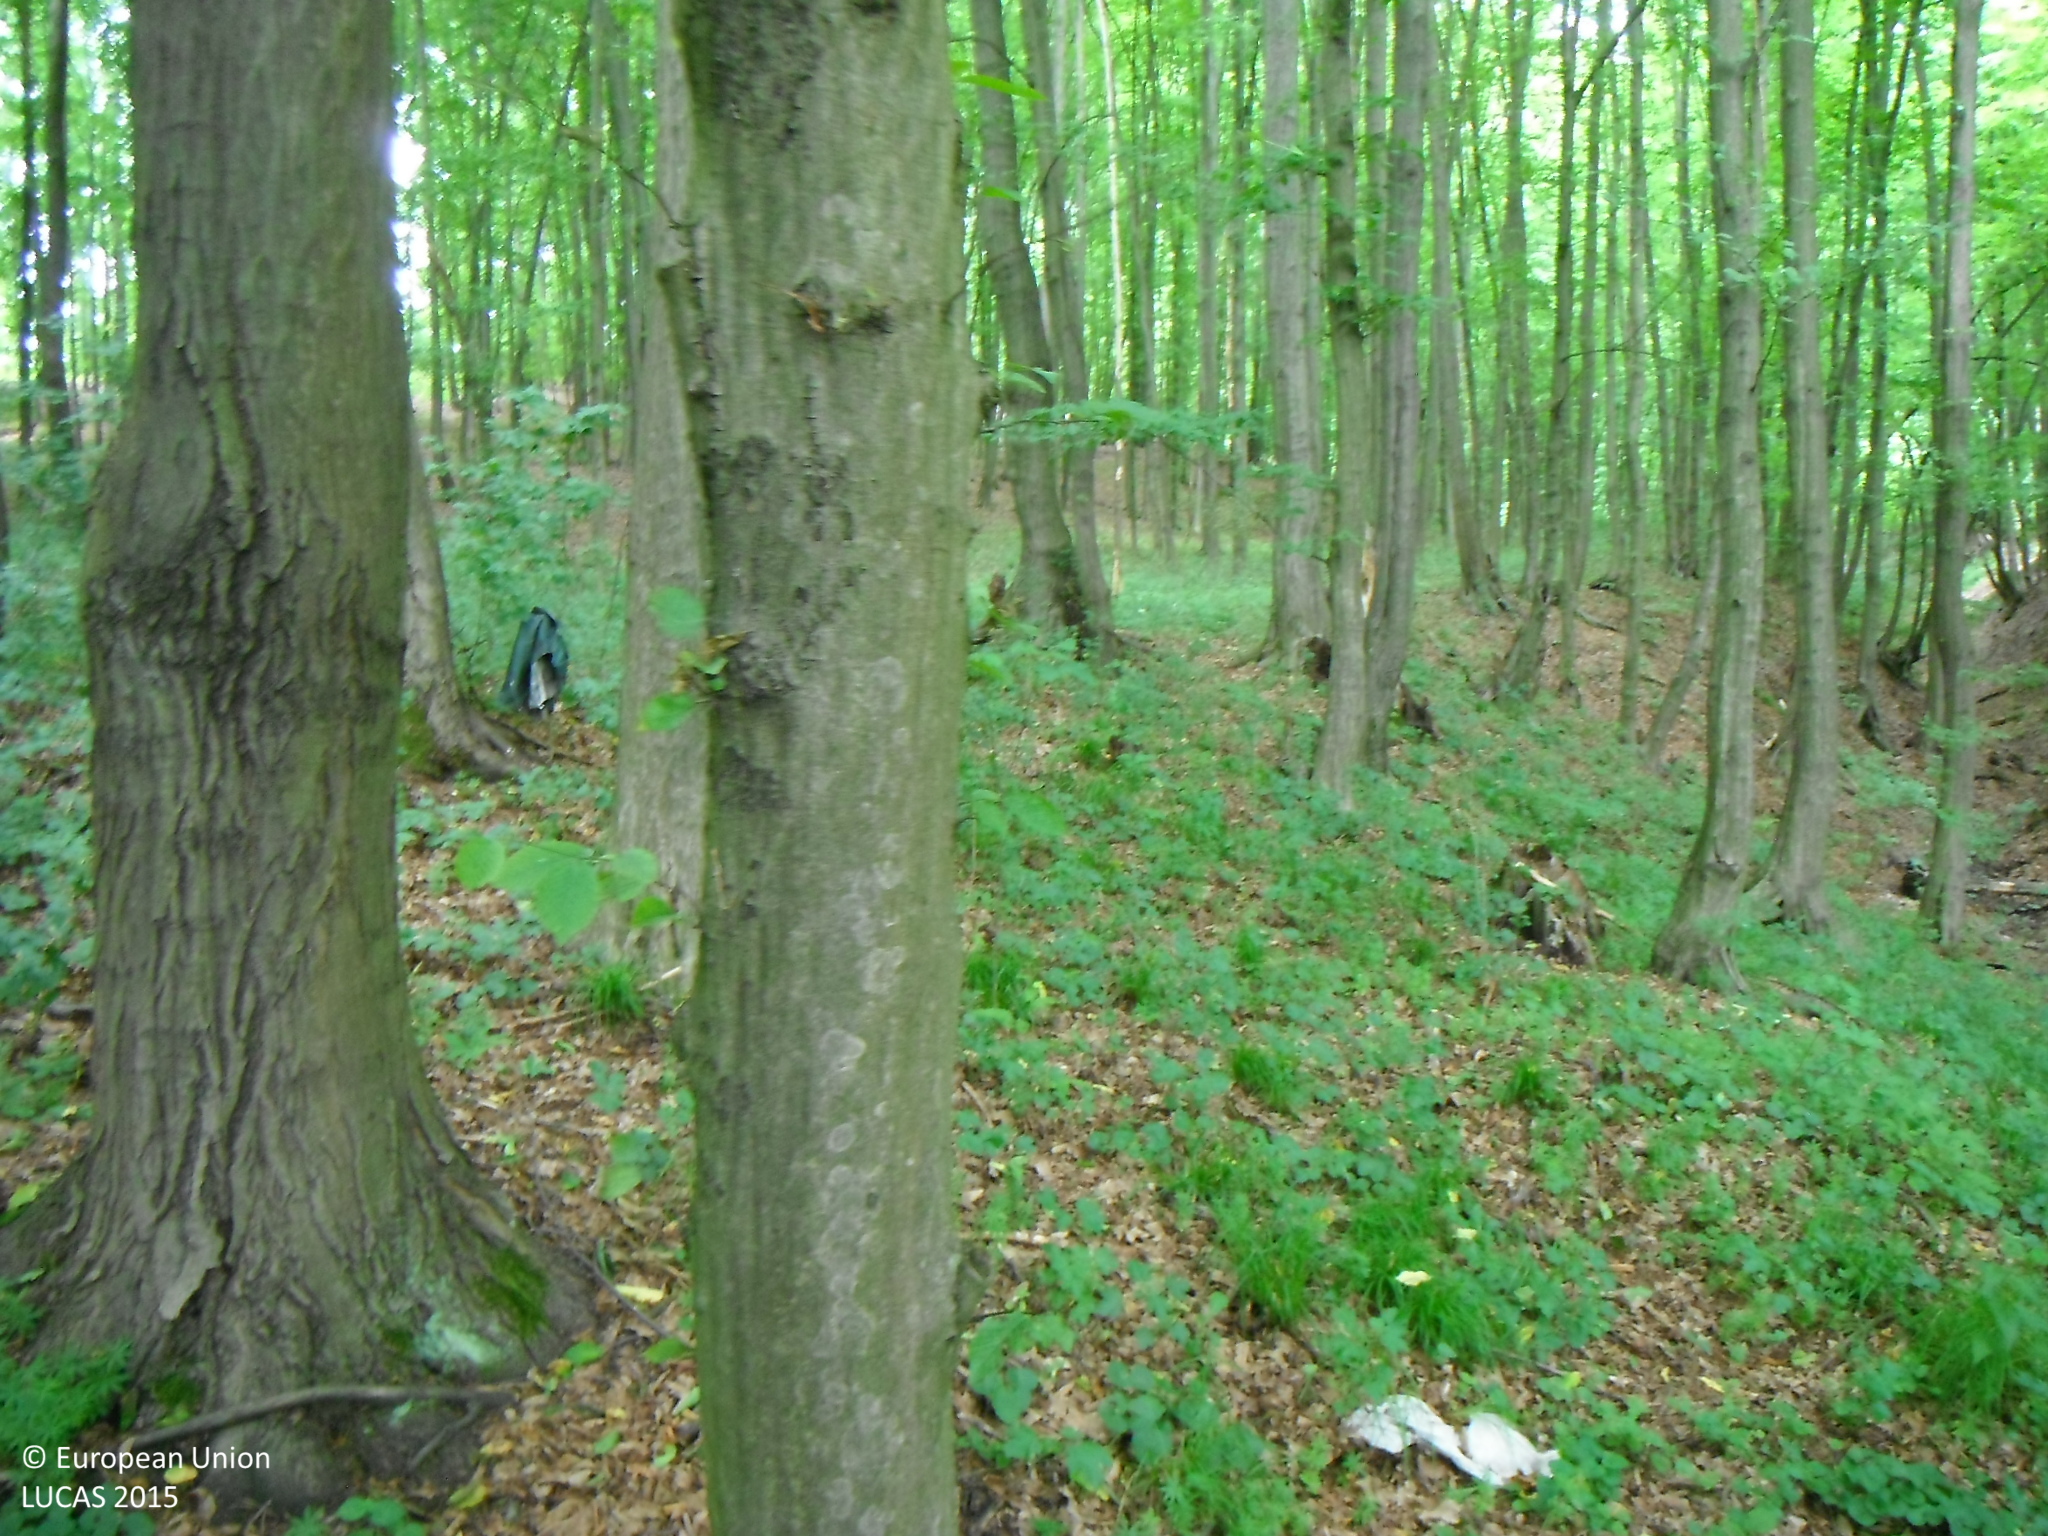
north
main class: Woodland
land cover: Broadleaved woodland
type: mesophytic deciduous forest
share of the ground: > 75 %
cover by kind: broadleaved forest trees 90 %, shrubs 5 %, herbaceous plants 5 %
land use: Forestry
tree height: > 5 m
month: June
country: SK
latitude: 48.5688
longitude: 19.9630
